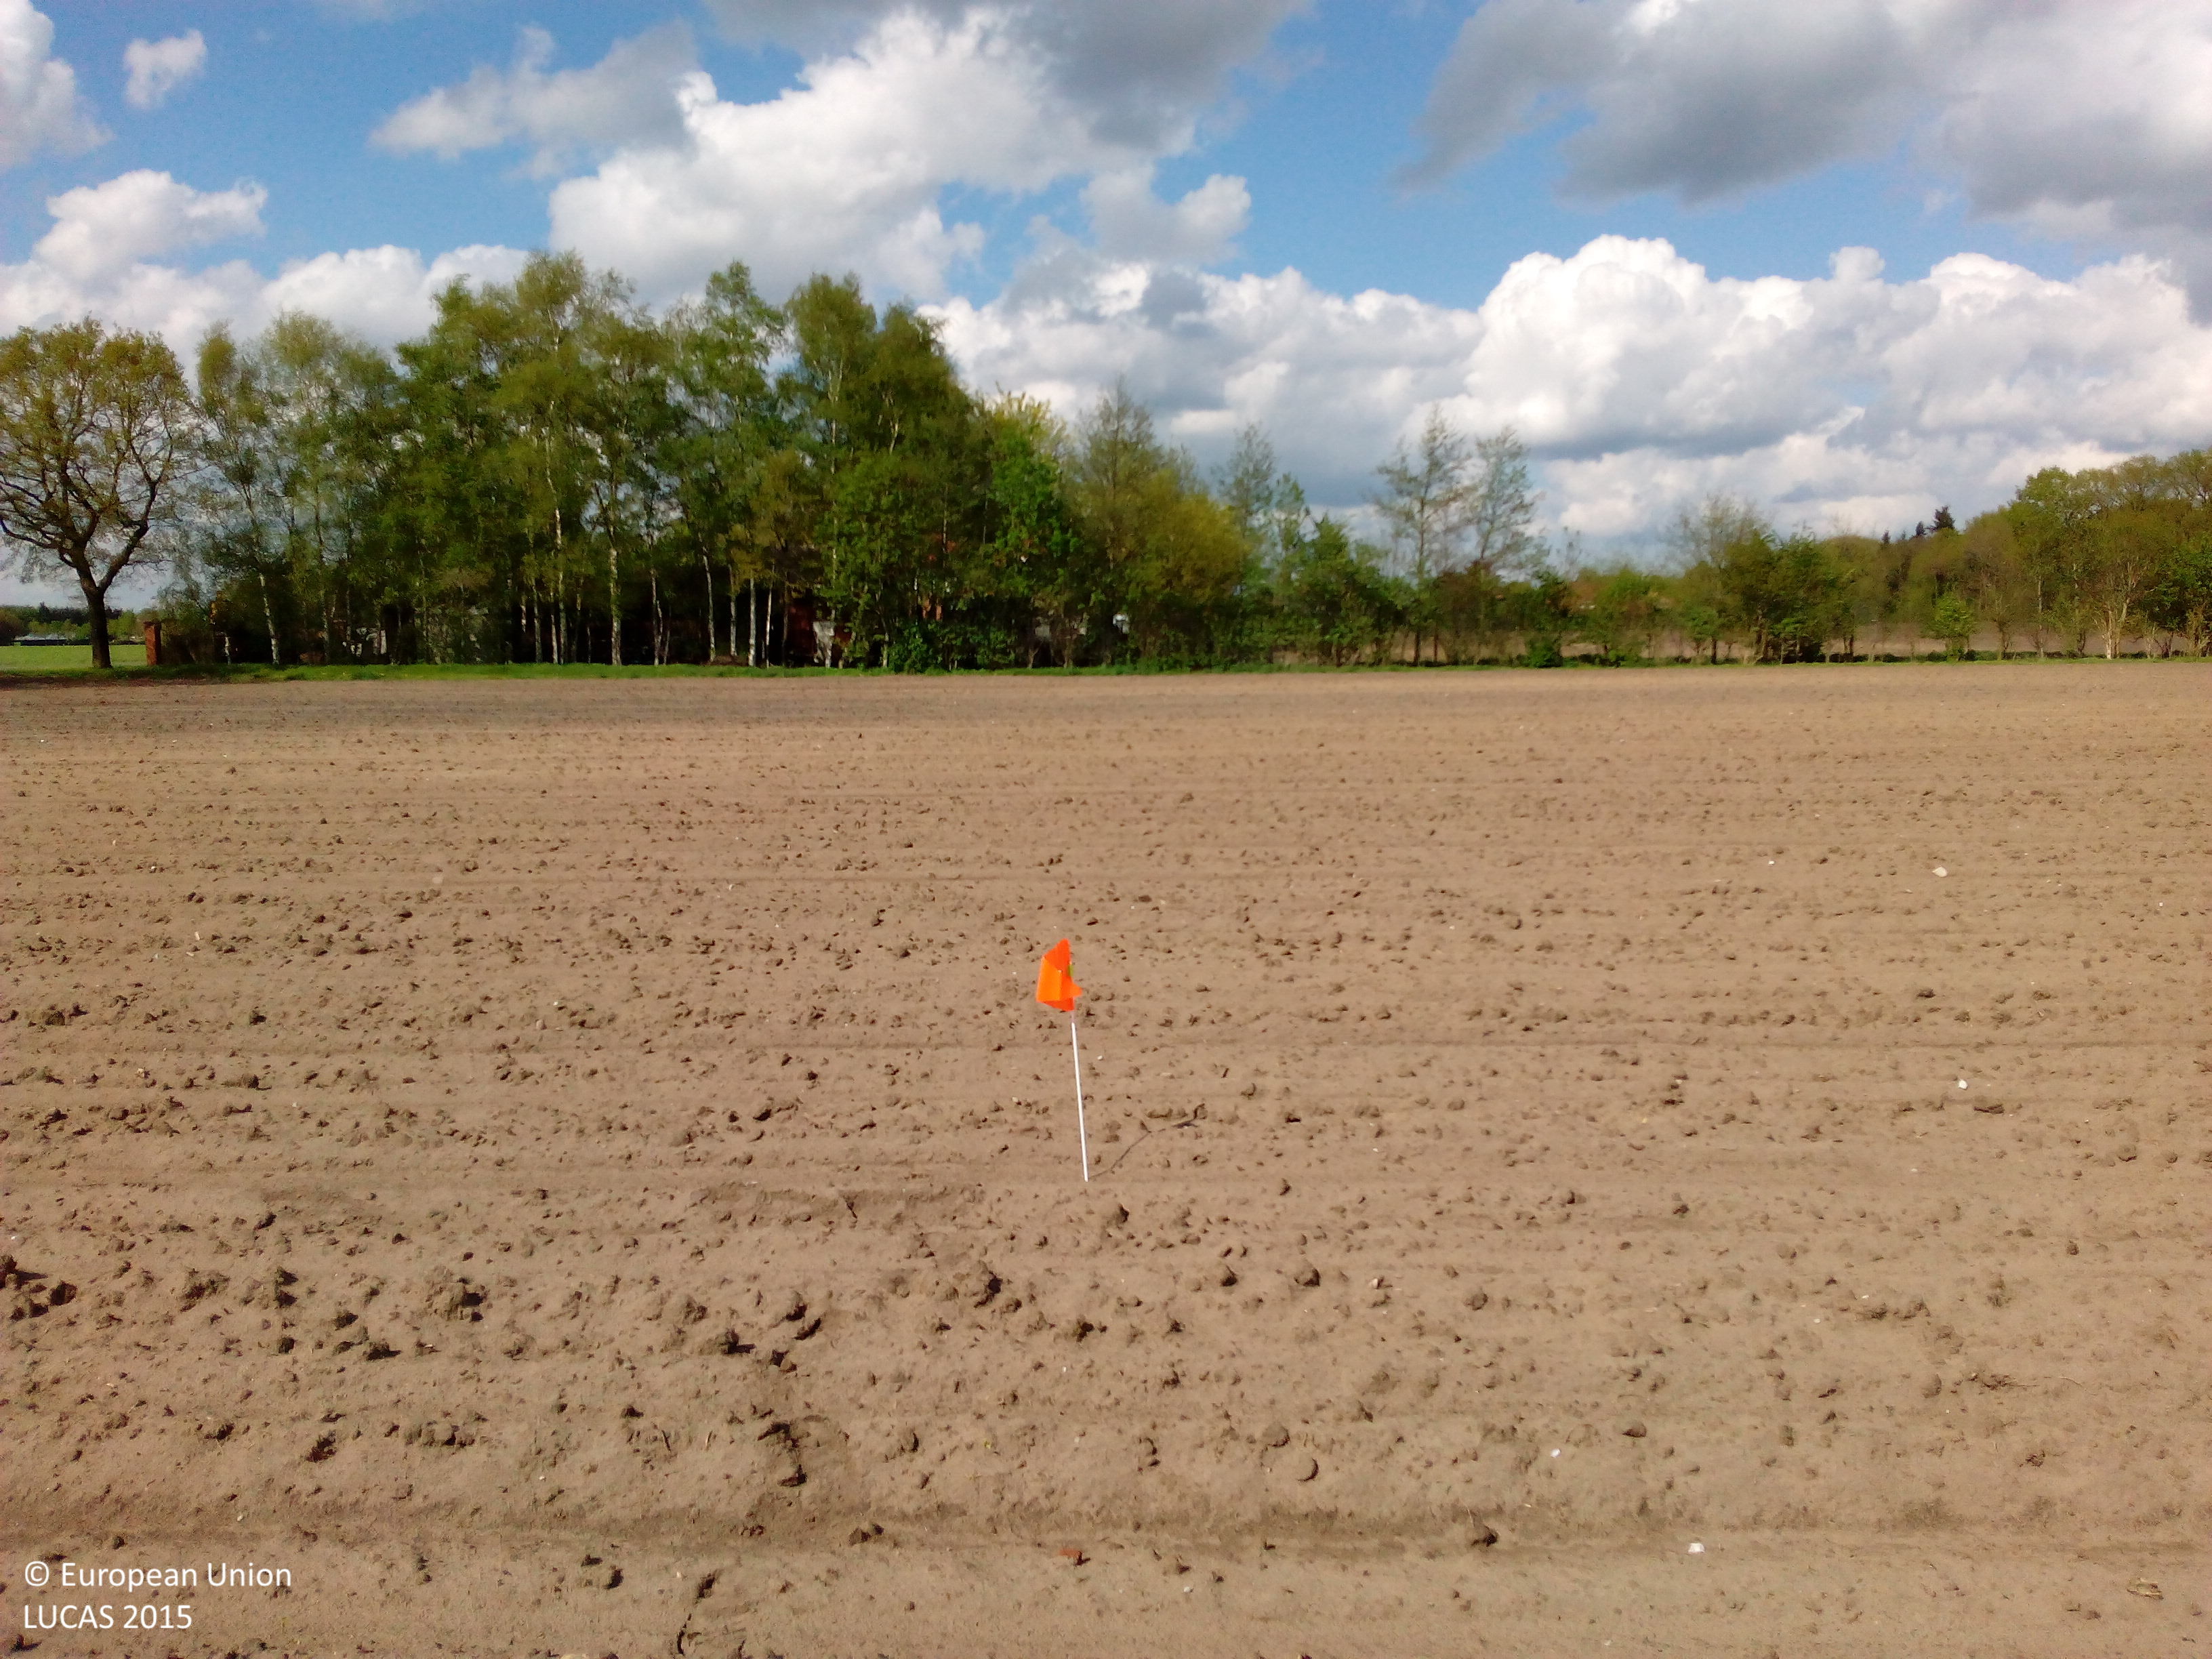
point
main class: Cropland
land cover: Sugar beet
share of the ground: < 10 %
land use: Agriculture (excluding fallow land and kitchen gardens)
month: May
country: DE
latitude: 52.9179
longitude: 7.9928
